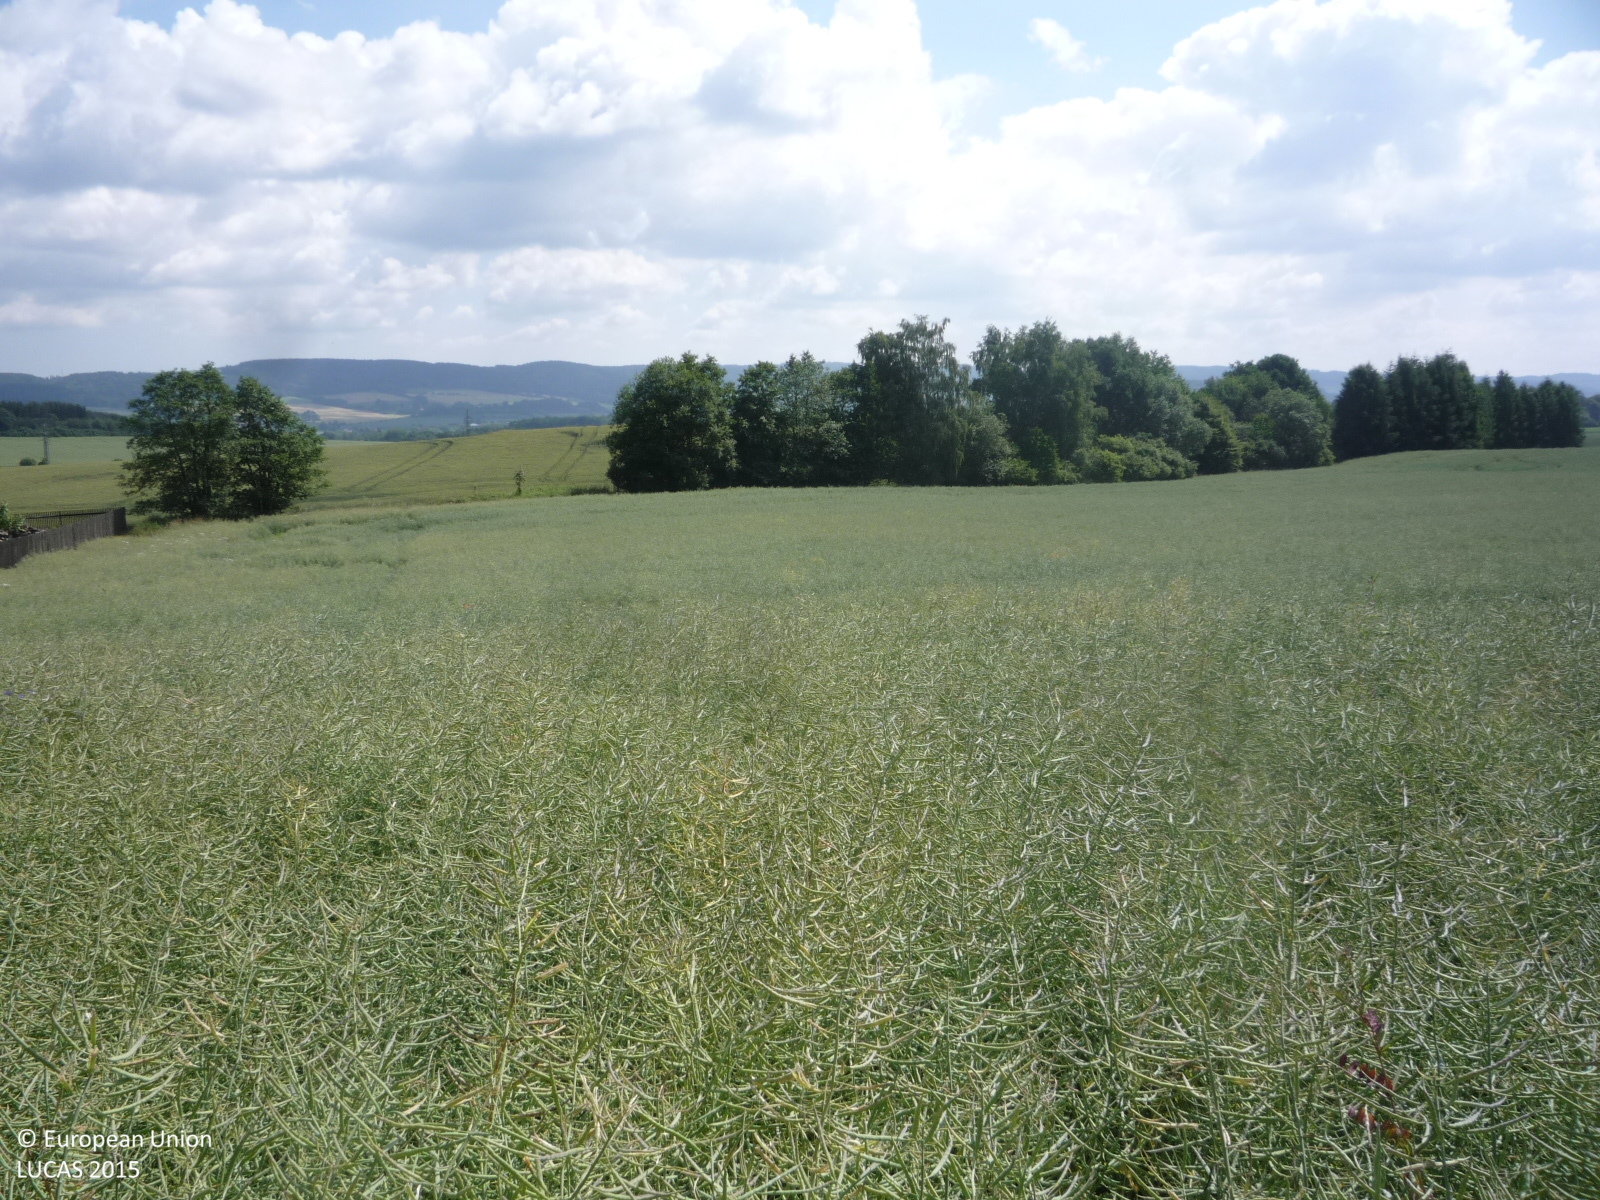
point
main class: Cropland
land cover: Rape and turnip rape
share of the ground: > 75 %
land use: Agriculture (excluding fallow land and kitchen gardens)
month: June
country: CZ
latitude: 49.7569
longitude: 15.6261
